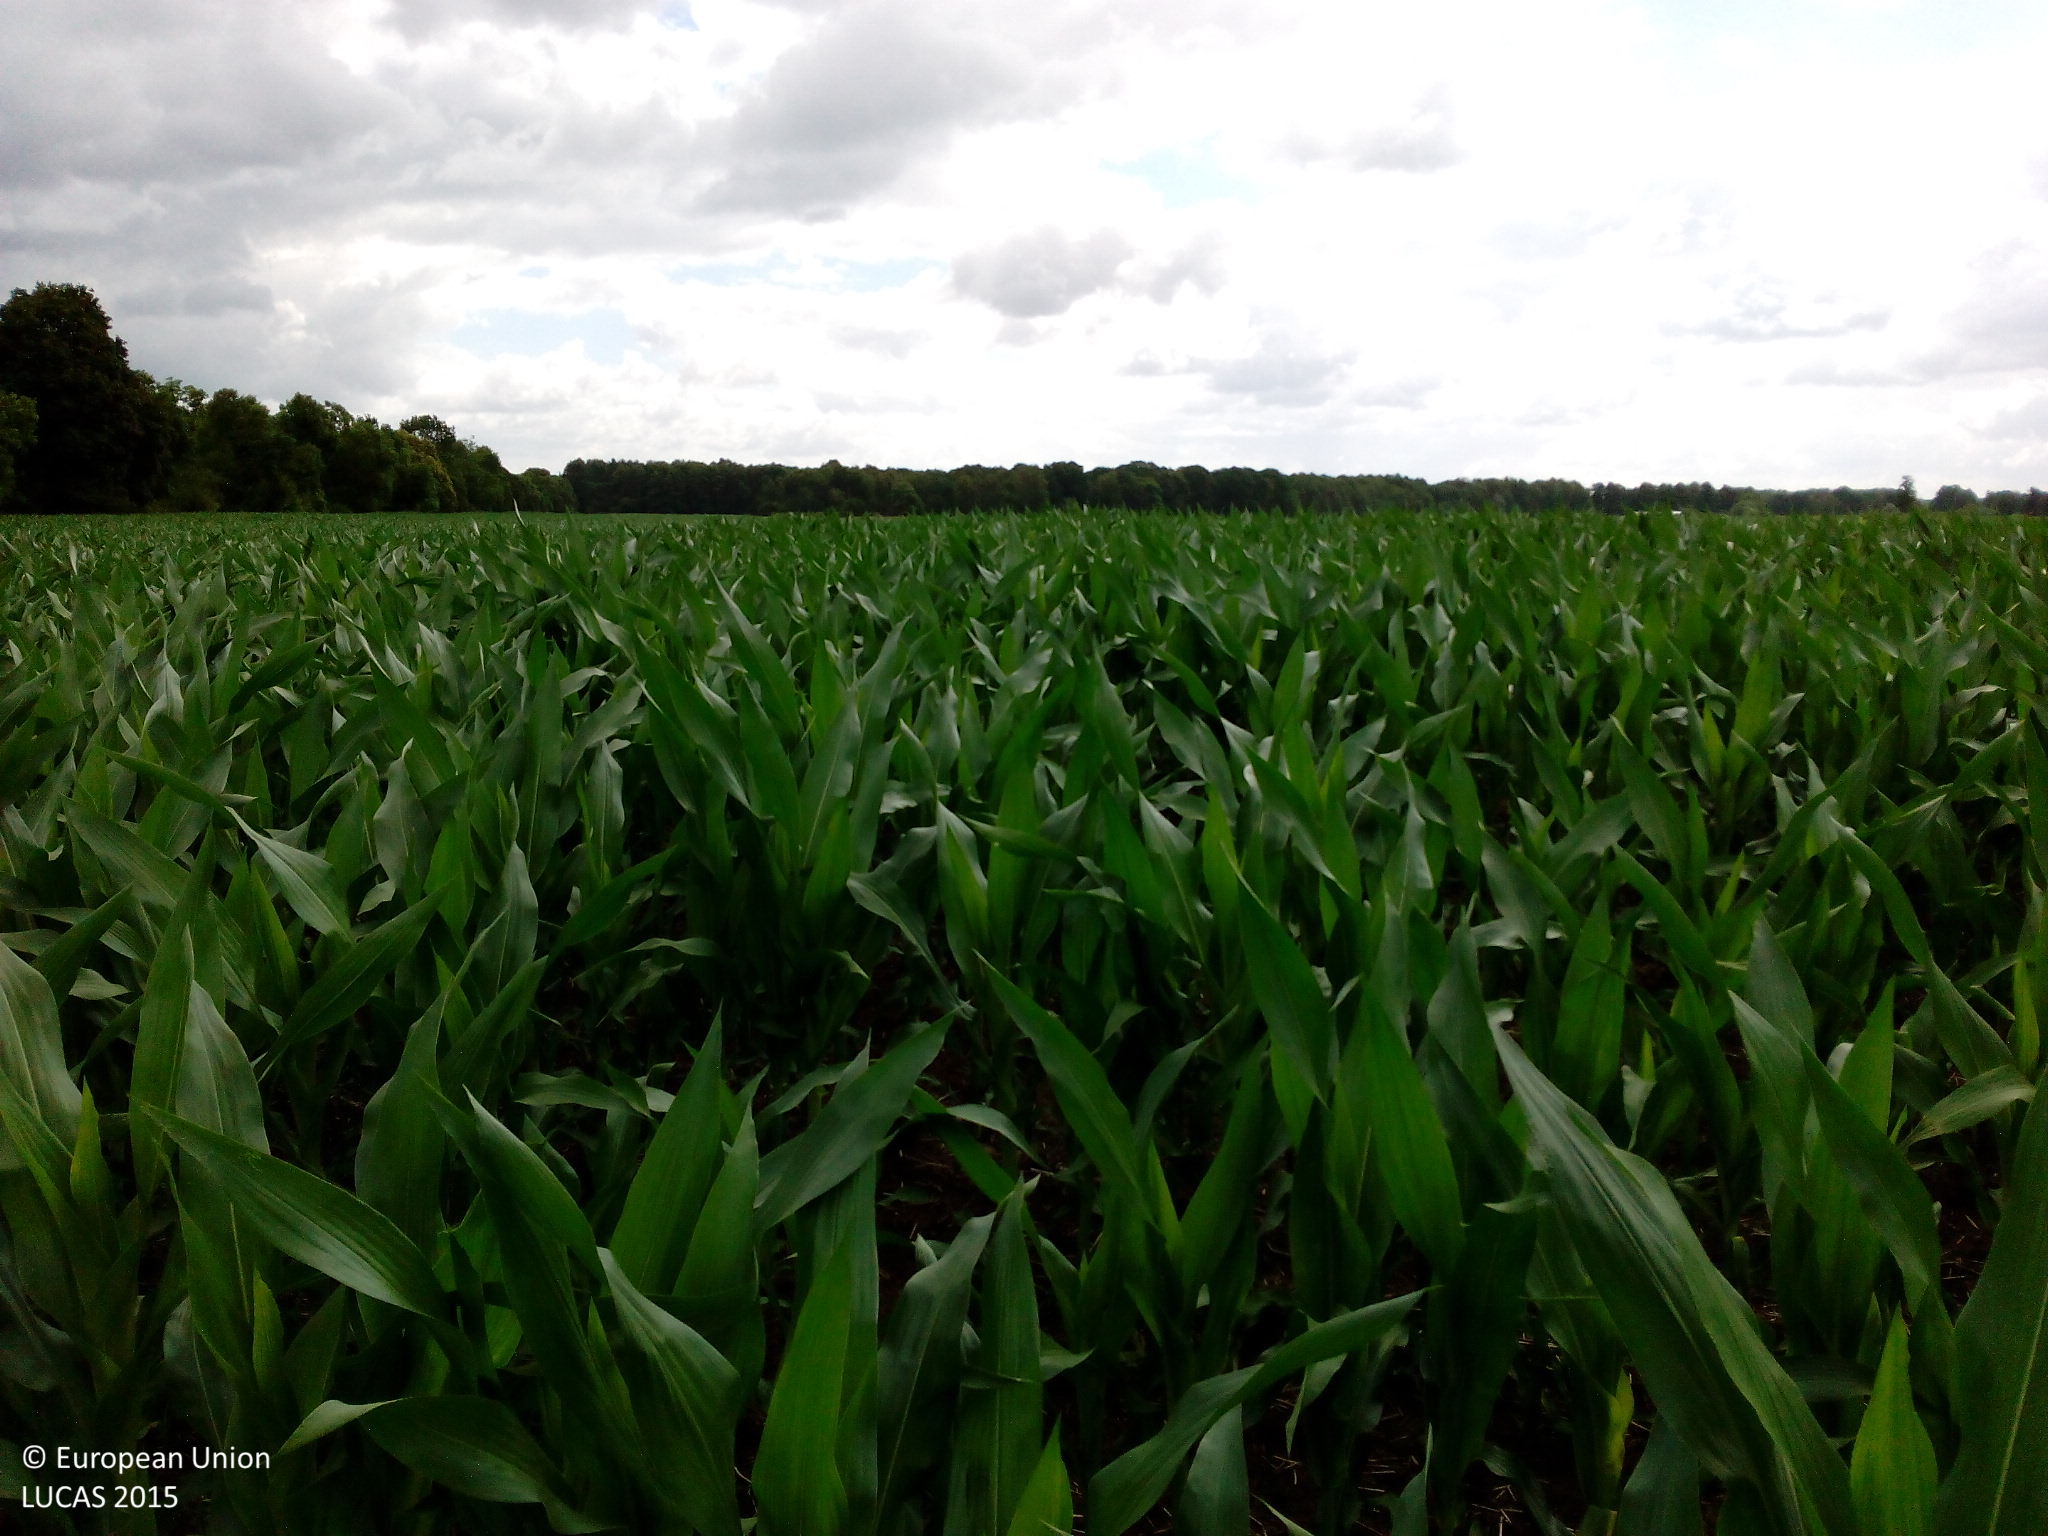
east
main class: Cropland
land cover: Maize
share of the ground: 50 - 75 %
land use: Agriculture (excluding fallow land and kitchen gardens)
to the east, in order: Maize
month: July
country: DE
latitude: 52.8462
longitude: 13.5488
